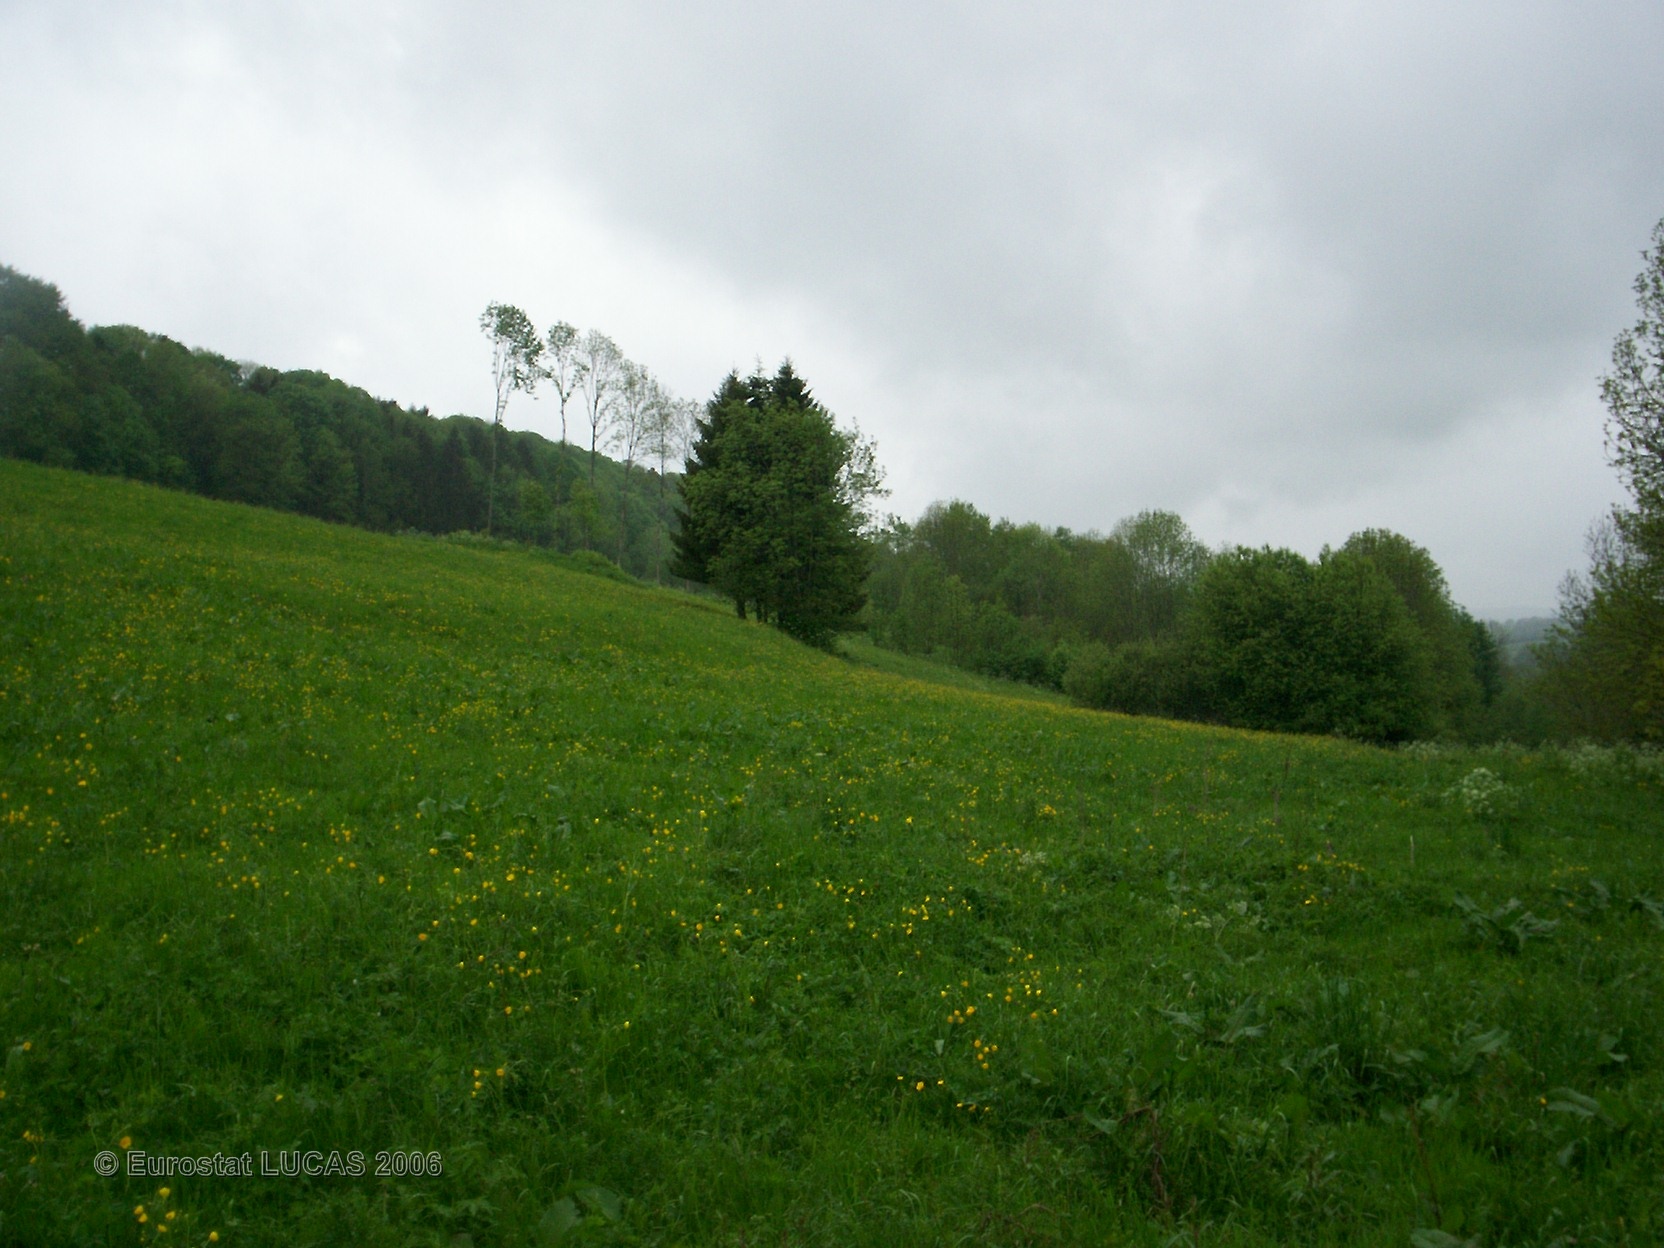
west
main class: Grassland
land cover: Grassland without tree/shrub cover
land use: Agriculture (excluding fallow land and kitchen gardens)
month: May
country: FR
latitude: 46.7845
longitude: 6.0860
